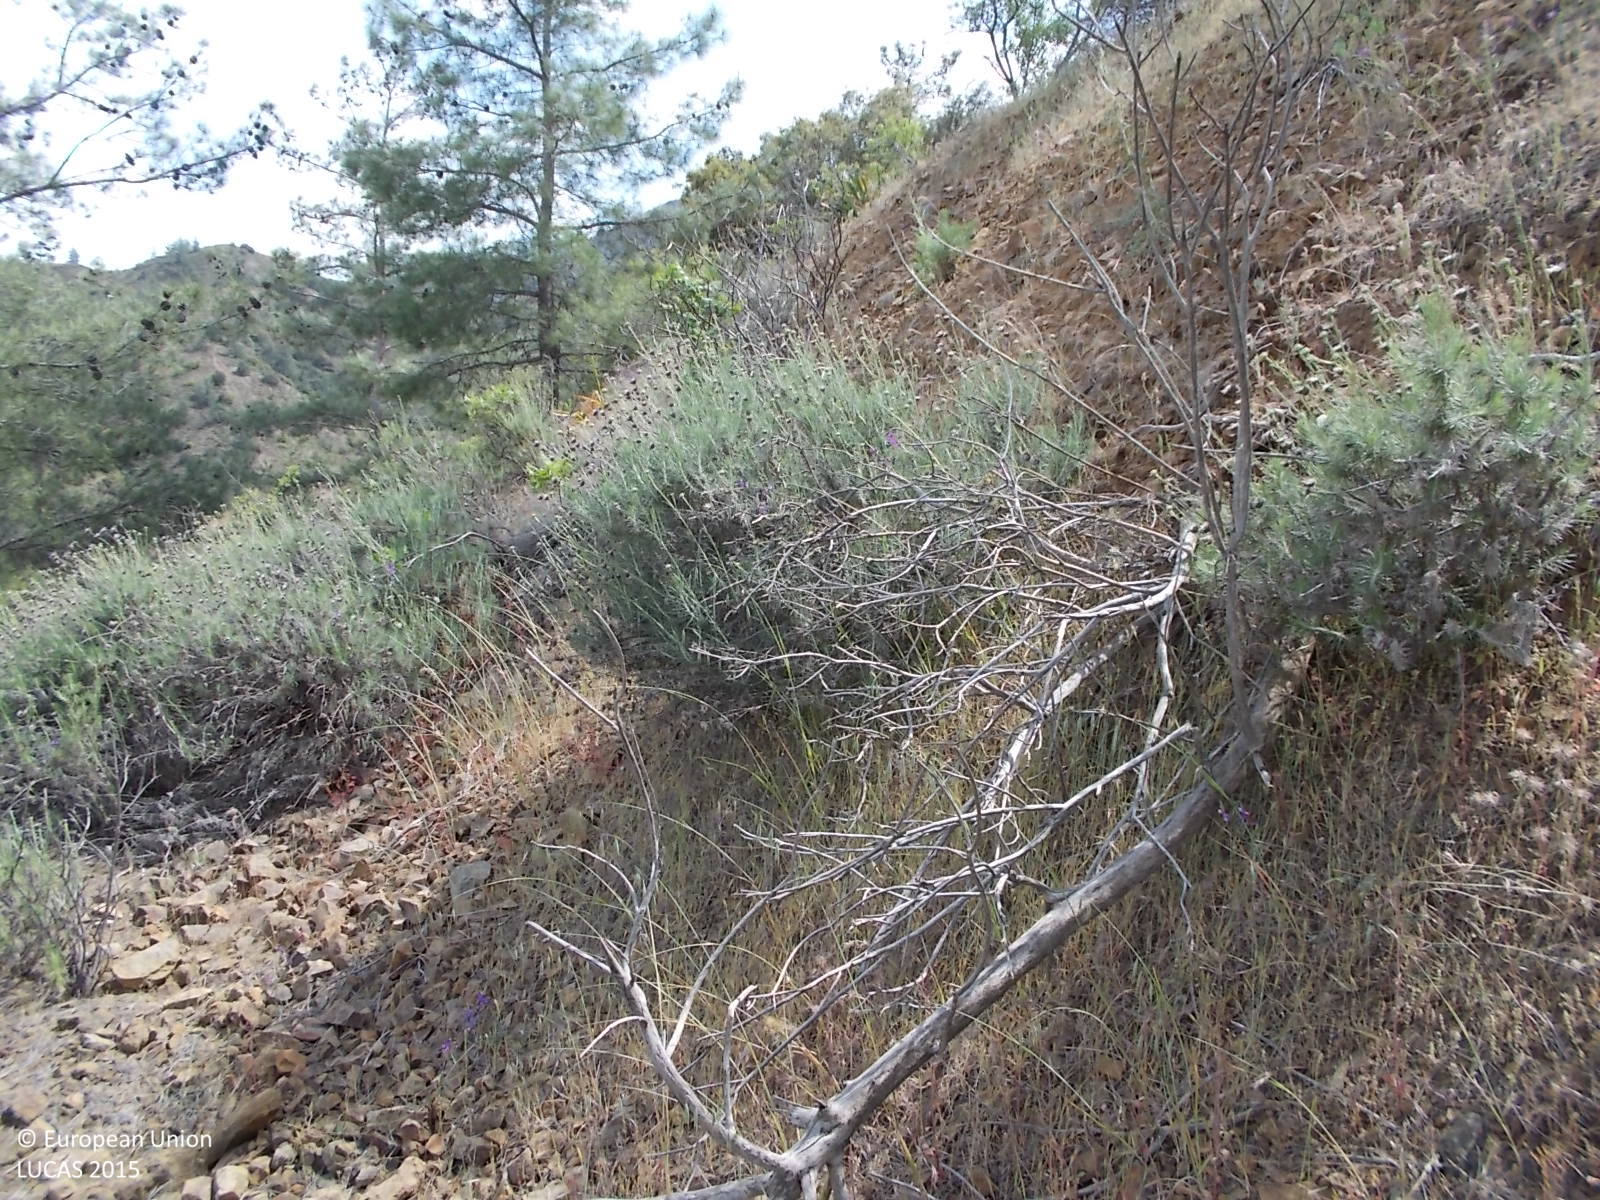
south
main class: Woodland
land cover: Pine dominated coniferous woodland
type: coniferous forest of the mediterranean region
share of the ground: > 75 %
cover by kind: coniferous forest trees 100 %
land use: Forestry
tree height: > 5 m
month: May
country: CY
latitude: 34.9622
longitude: 33.0756
